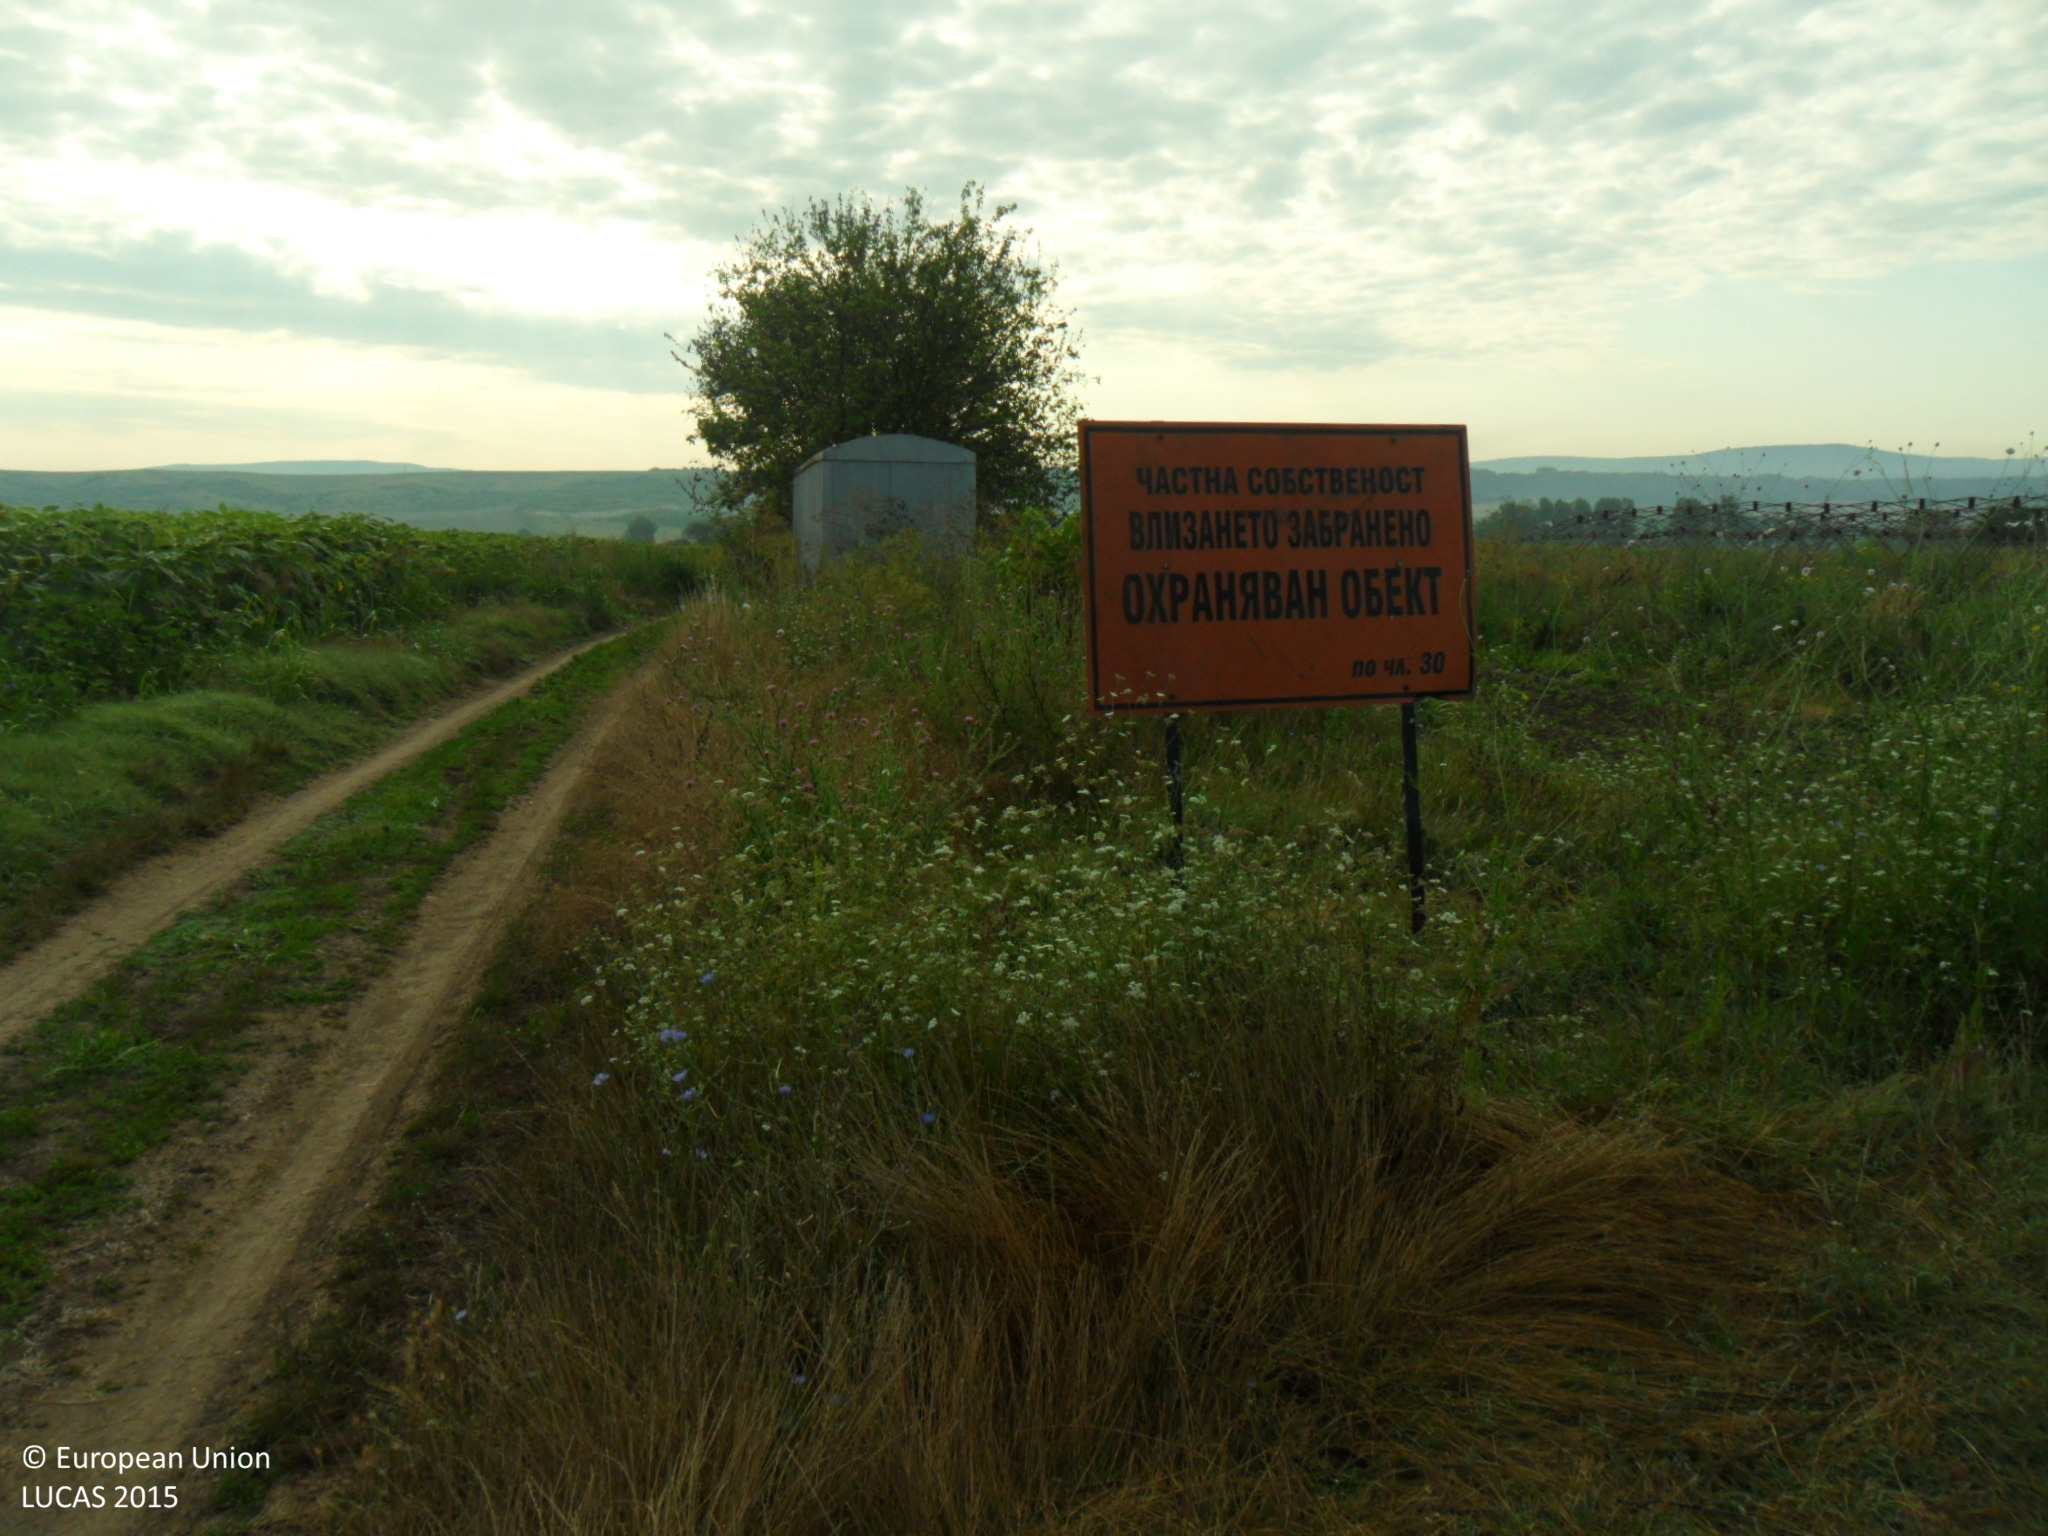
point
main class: Cropland
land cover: Maize
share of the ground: > 75 %
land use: Agriculture (excluding fallow land and kitchen gardens)
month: July
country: BG
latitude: 43.1914
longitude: 27.0086
